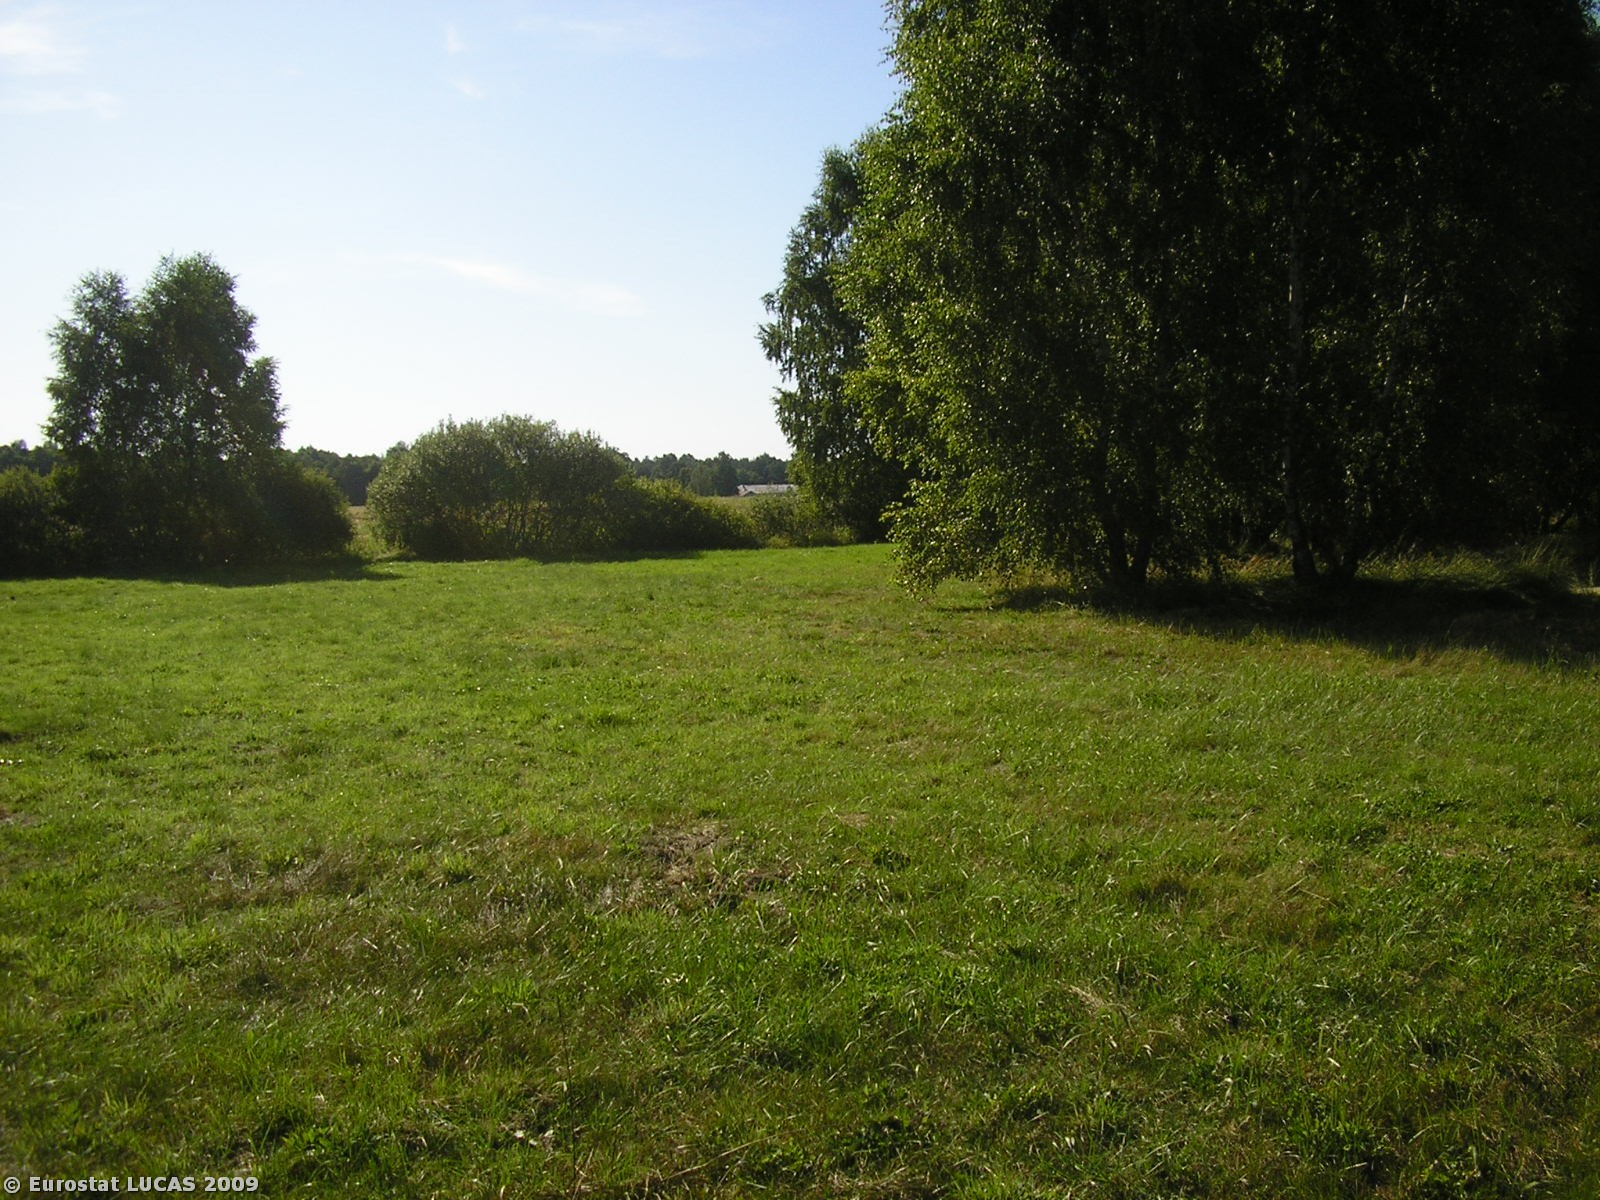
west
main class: Grassland
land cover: Grassland without tree/shrub cover
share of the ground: > 75 %
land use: Agriculture (excluding fallow land and kitchen gardens)
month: August
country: PL
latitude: 51.9973
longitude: 19.4802
